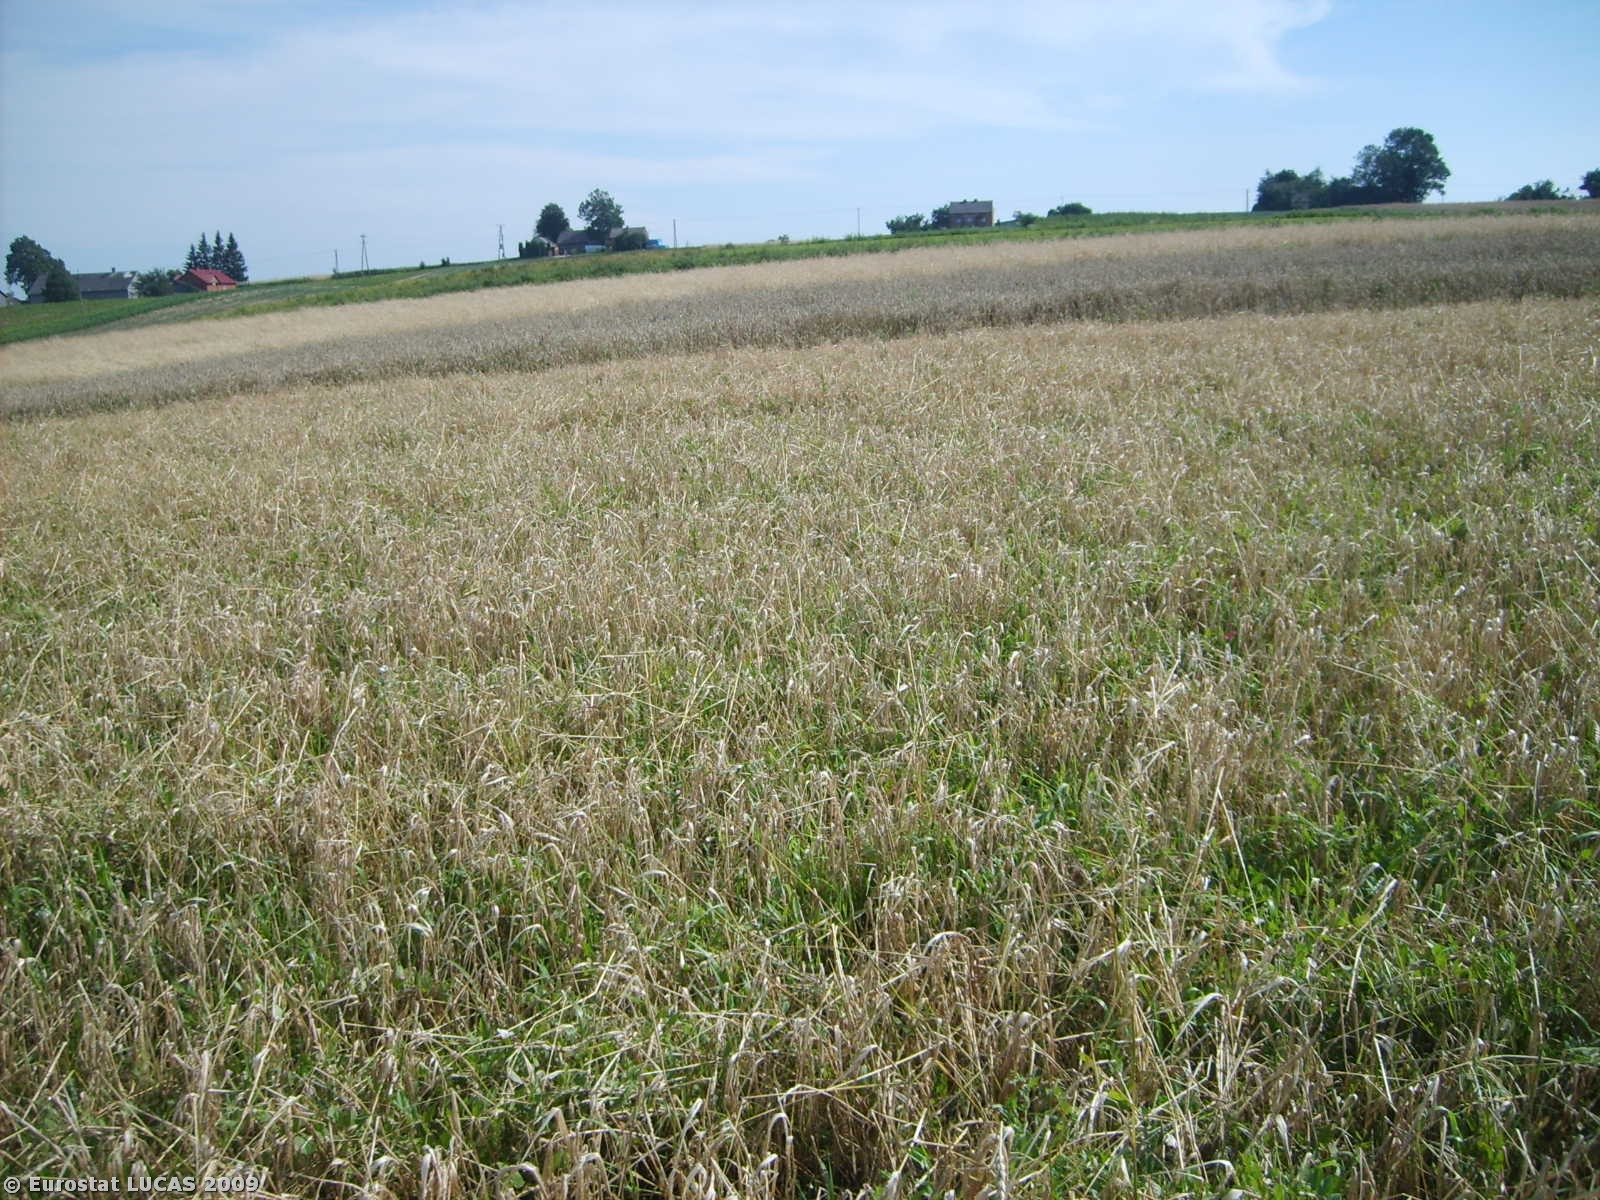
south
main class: Cropland
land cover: Mixed cereals for fodder
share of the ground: 25 - 50 %
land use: Agriculture (excluding fallow land and kitchen gardens)
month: July
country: PL
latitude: 50.2105
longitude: 20.2502
